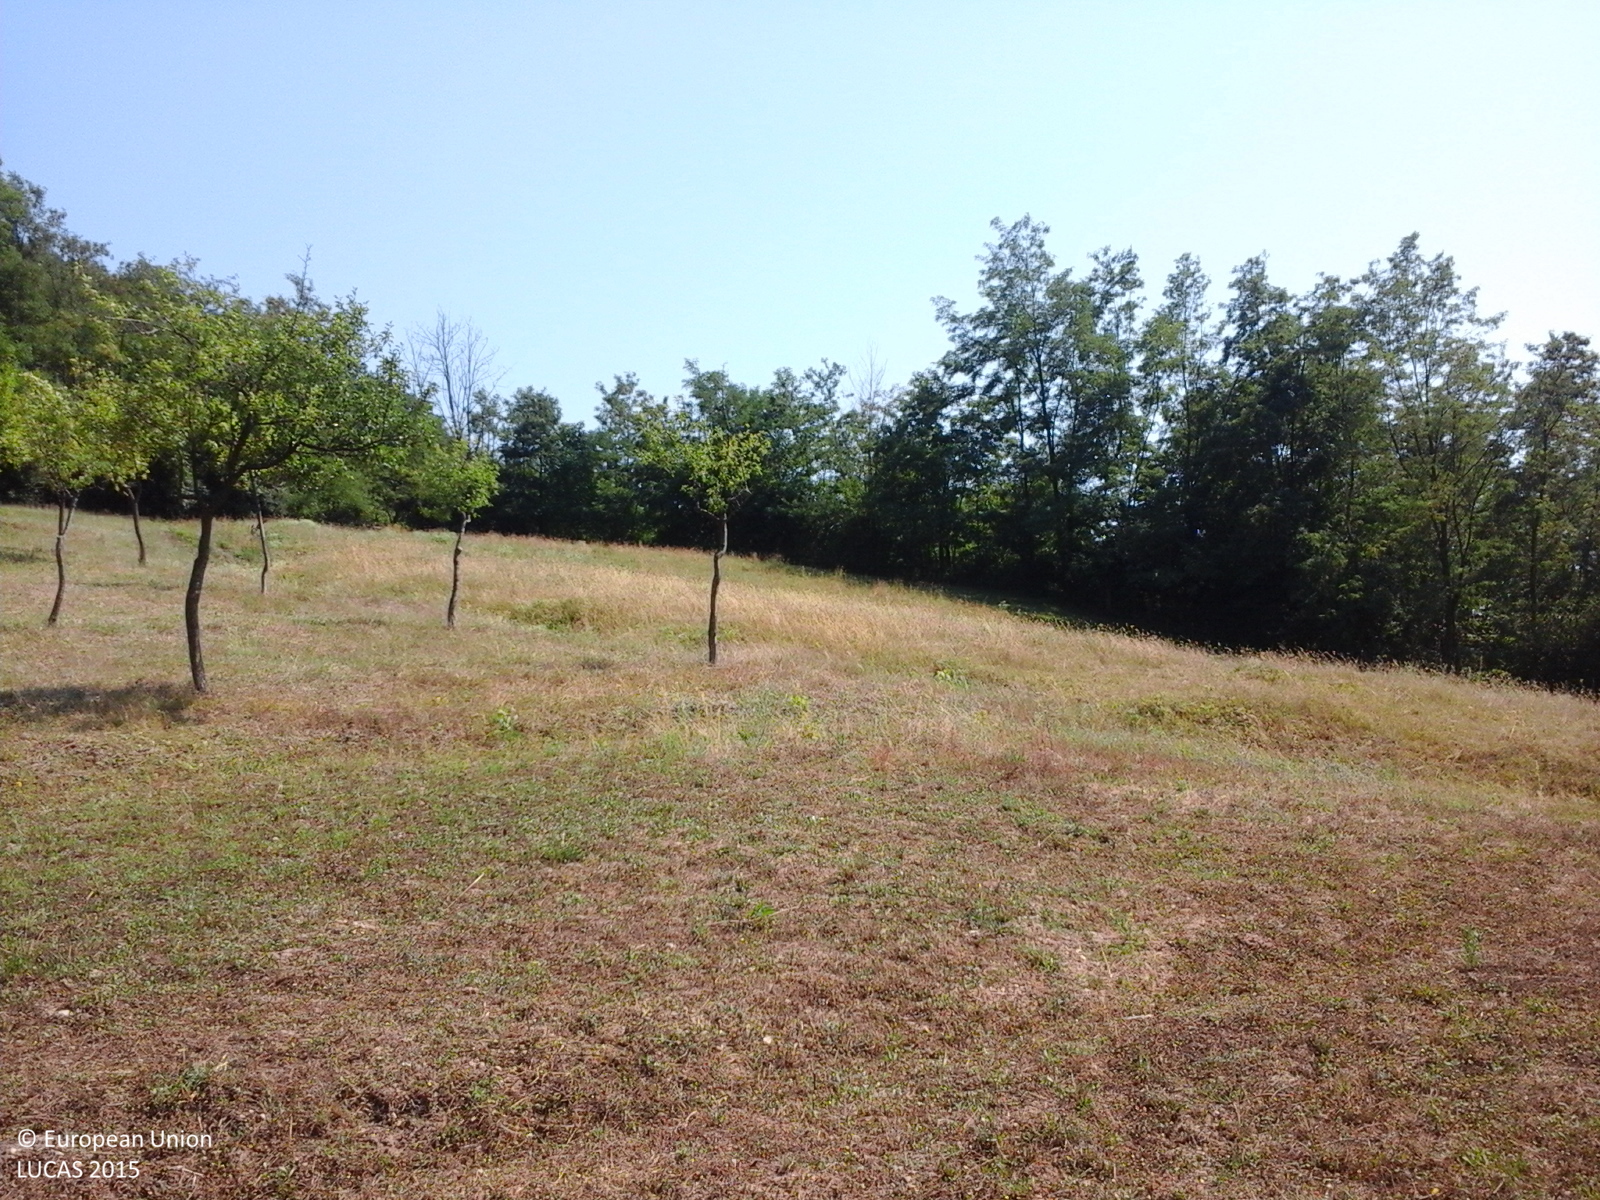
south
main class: Grassland
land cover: Grassland without tree/shrub cover
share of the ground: 50 - 75 %
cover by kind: herbaceous plants 100 %
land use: Agriculture (excluding fallow land and kitchen gardens)
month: July
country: RO
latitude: 44.8713
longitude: 24.4395
